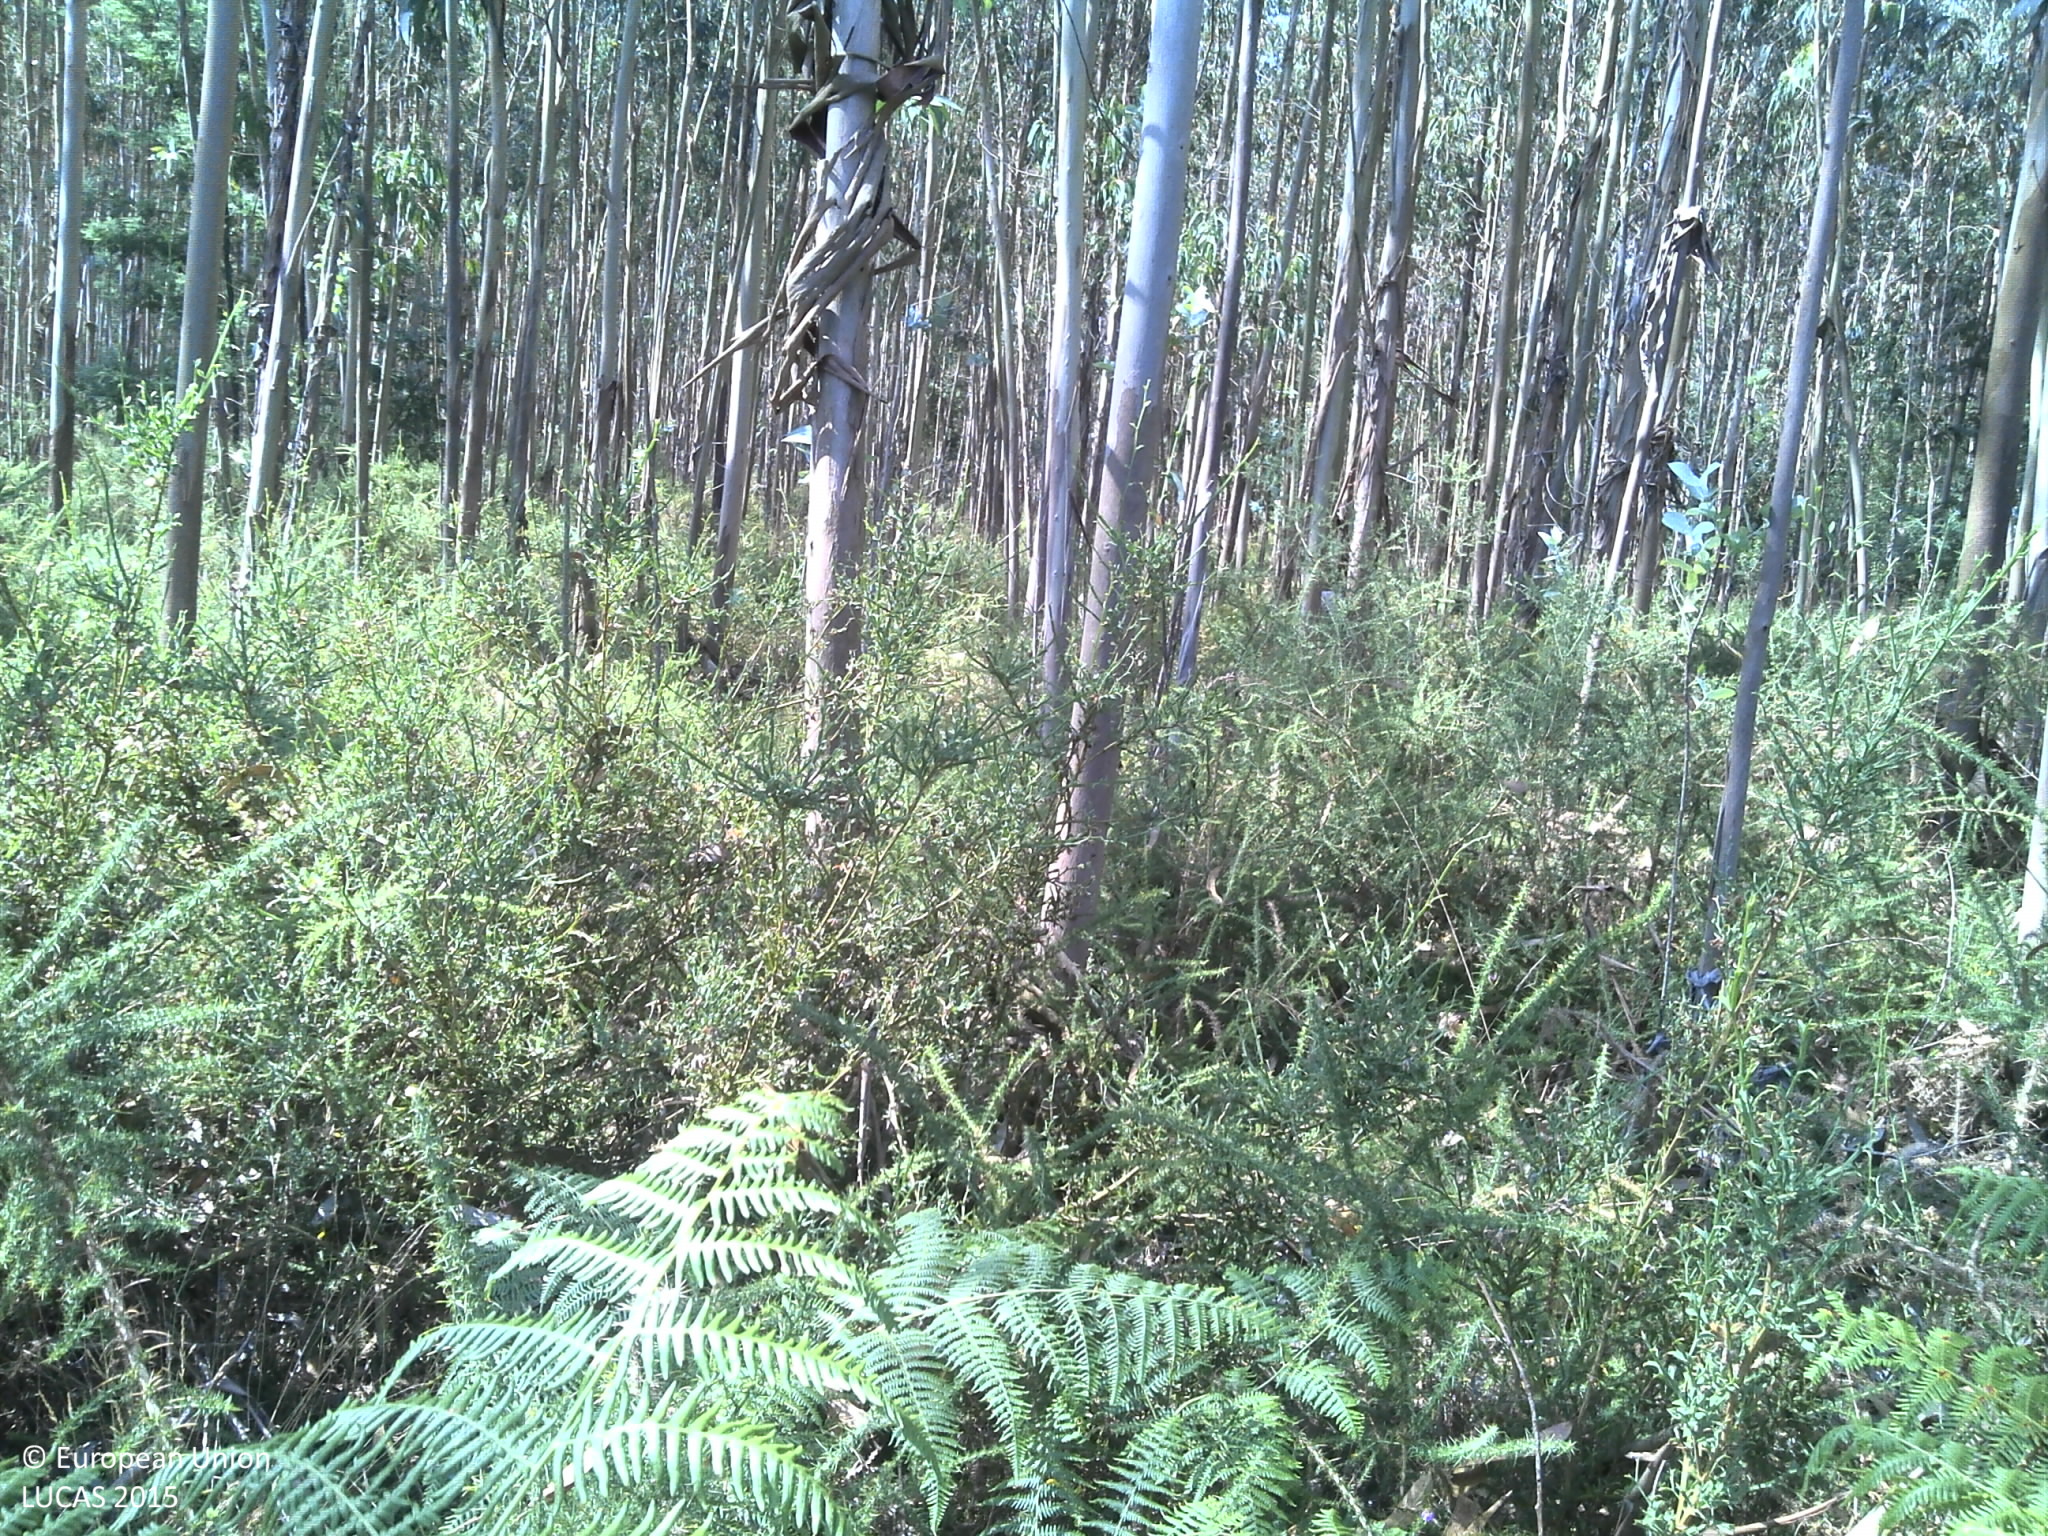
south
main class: Woodland
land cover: Broadleaved woodland
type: exotic forest
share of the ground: 25 - 50 %
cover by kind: broadleaved forest trees 50 %, shrubs 25 %, unconsolidated bare surface 25 %
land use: Forestry
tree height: > 5 m
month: July
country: PT
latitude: 40.5965
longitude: -8.4177
